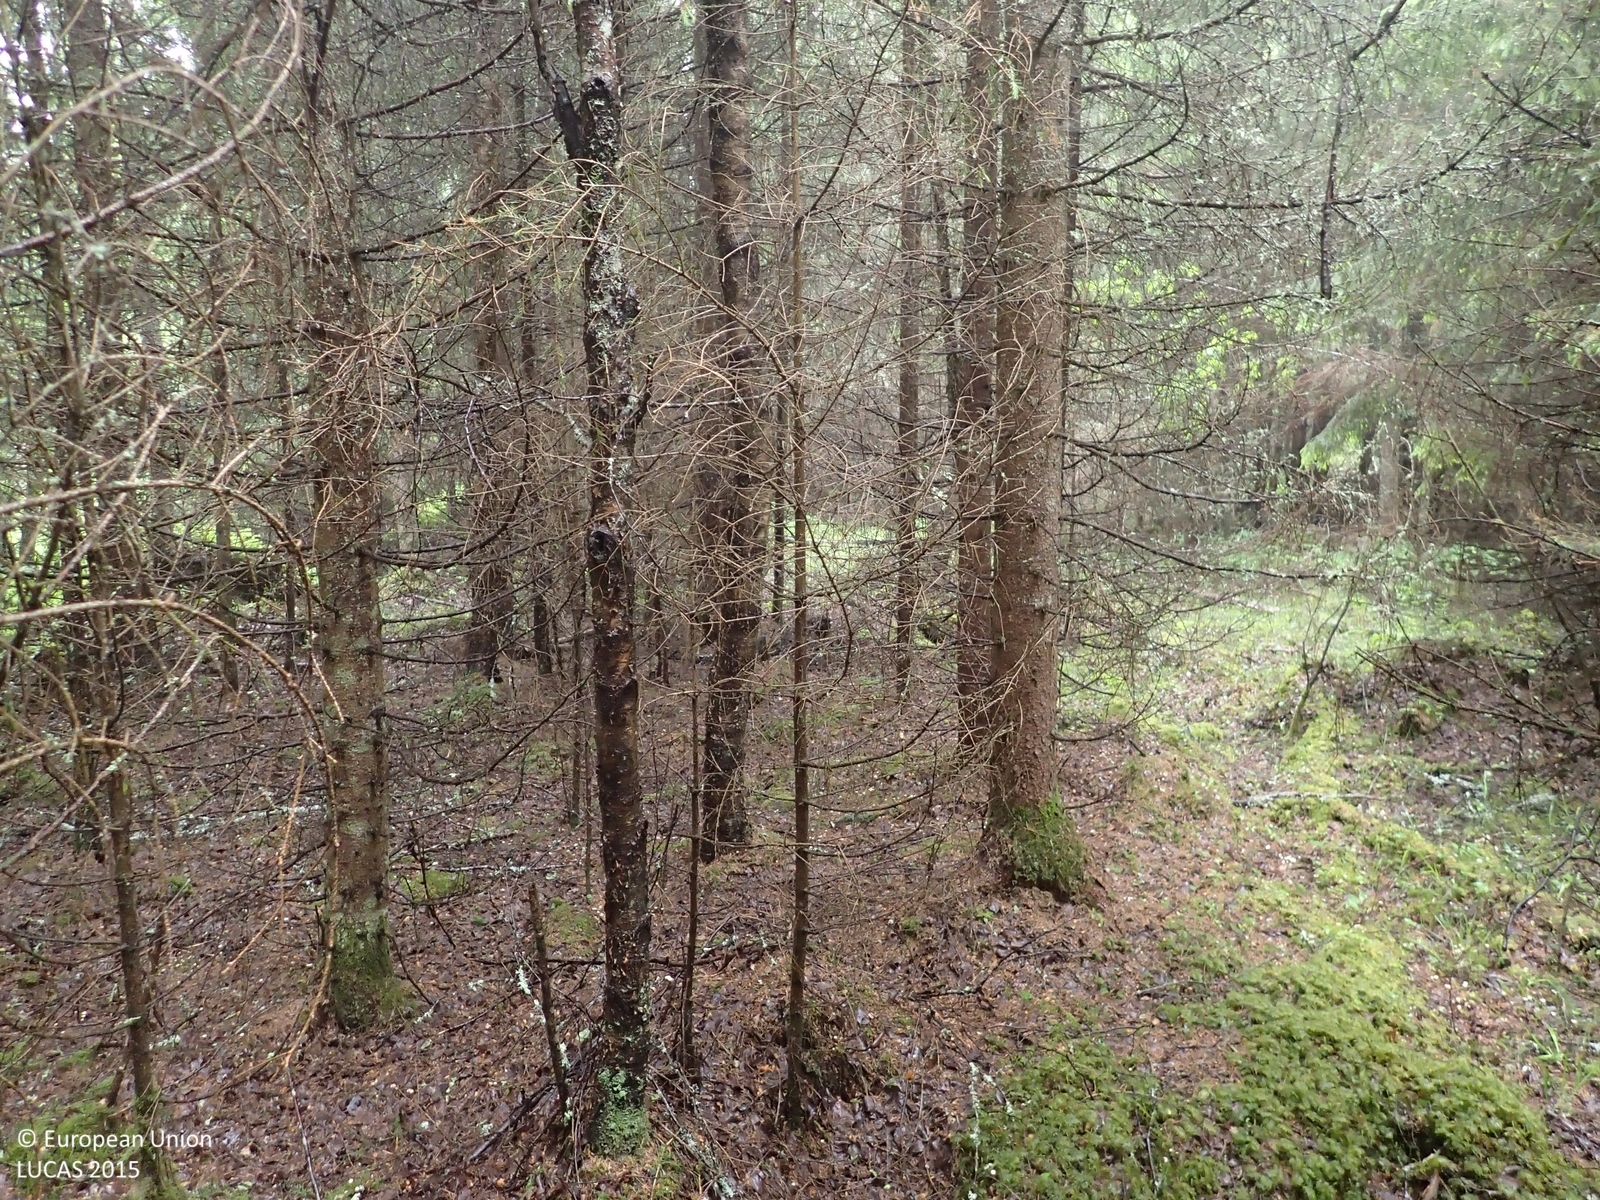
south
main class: Woodland
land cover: Spruce dominated mixed woodland
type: boreal forest
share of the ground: > 75 %
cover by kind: coniferous forest trees 65 %, broadleaved forest trees 25 %, shrubs 5 %, herbaceous plants 5 %
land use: Forestry
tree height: > 5 m
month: June
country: FI
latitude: 62.2938
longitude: 21.5554
